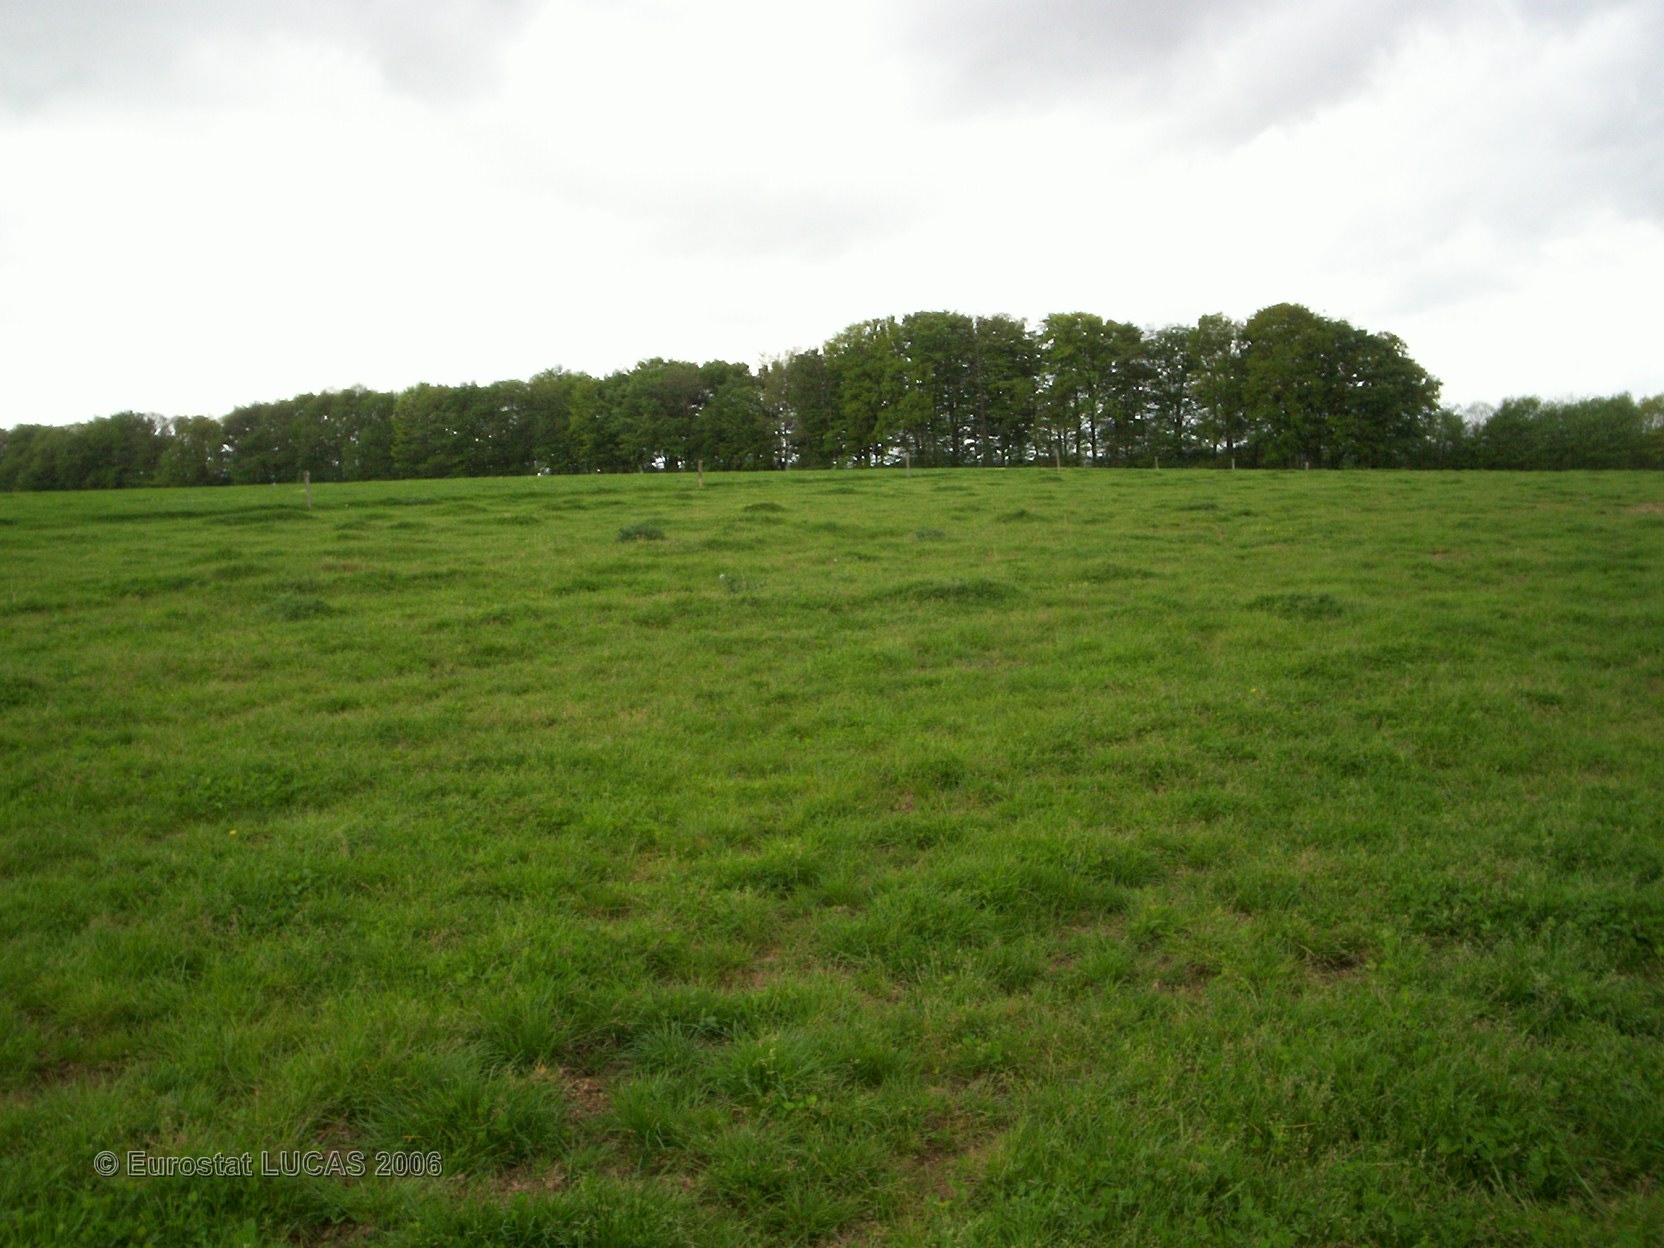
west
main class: Grassland
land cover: Grassland without tree/shrub cover
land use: Agriculture (excluding fallow land and kitchen gardens)
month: May
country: FR
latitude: 48.3845
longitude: -2.7995
